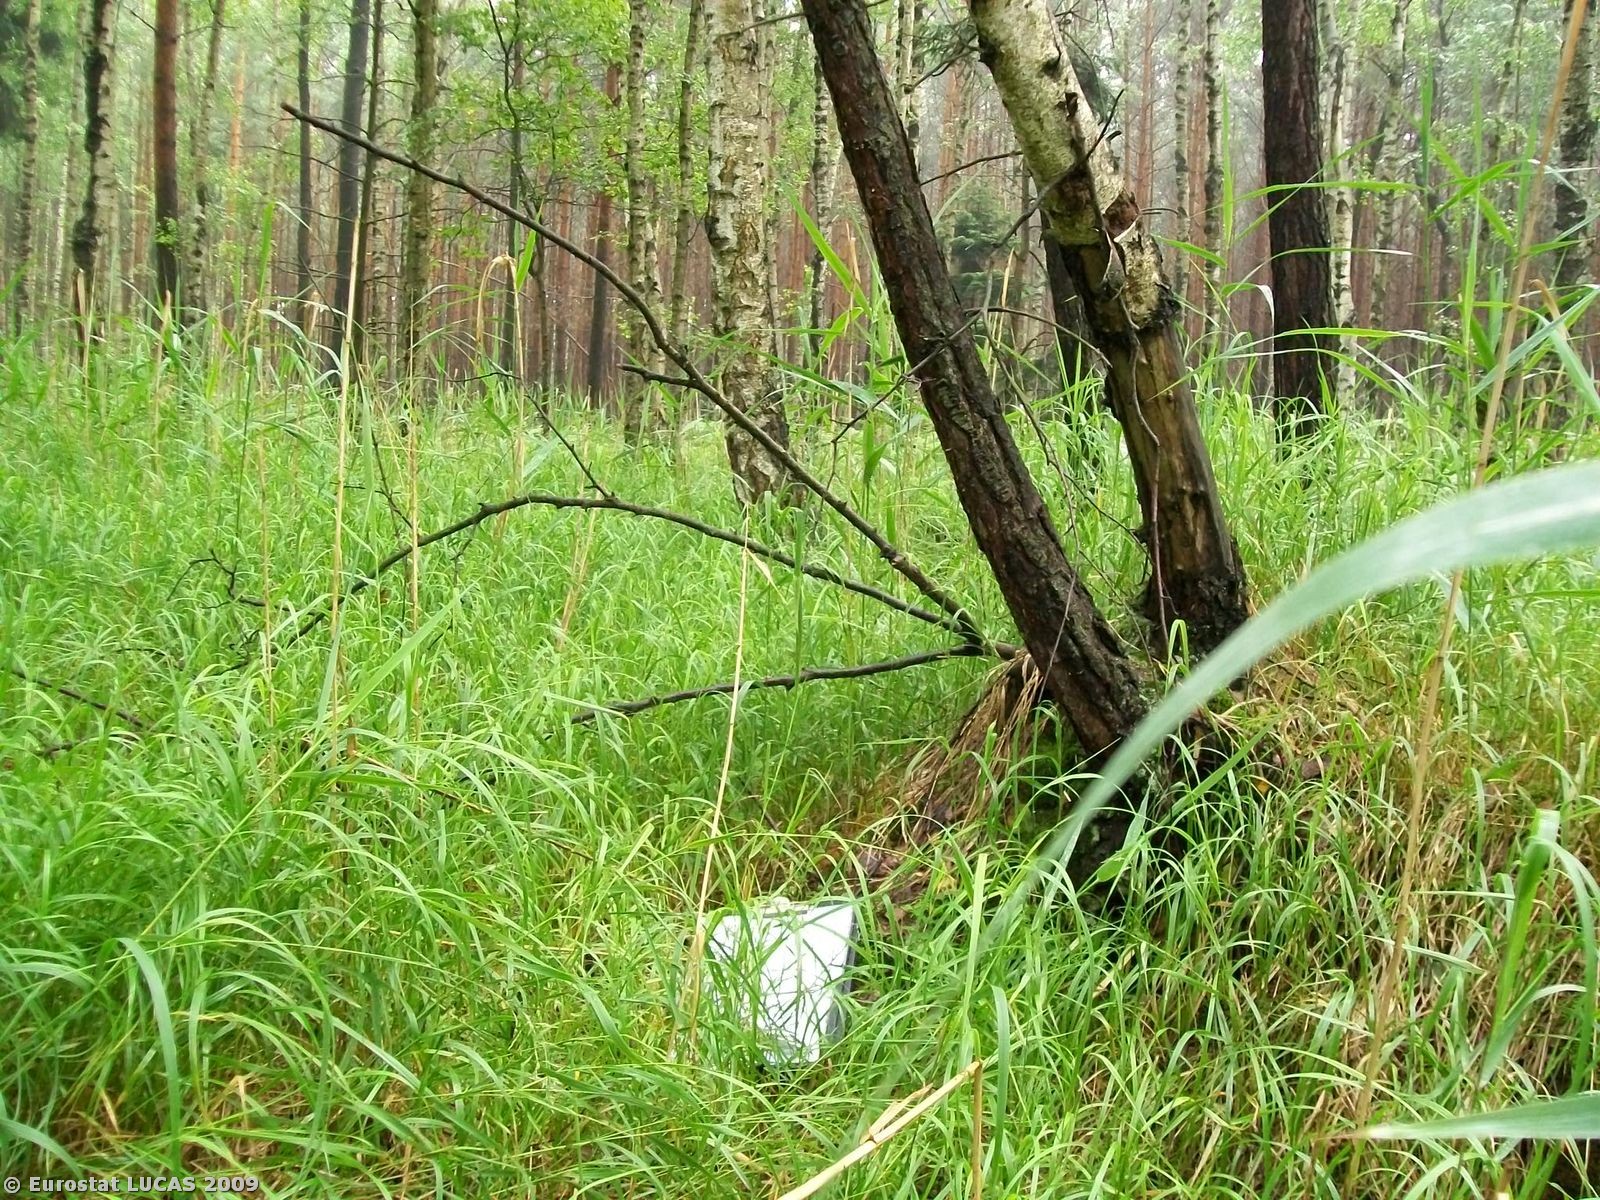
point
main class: Woodland
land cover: Mixed woodland
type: hemiboreal forest and nemoral coniferous forest and mixed broadleaved-coniferous forest
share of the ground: > 75 %
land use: Nature reserves
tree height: > 5 m
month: June
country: PL
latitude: 51.3455
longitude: 15.1862
